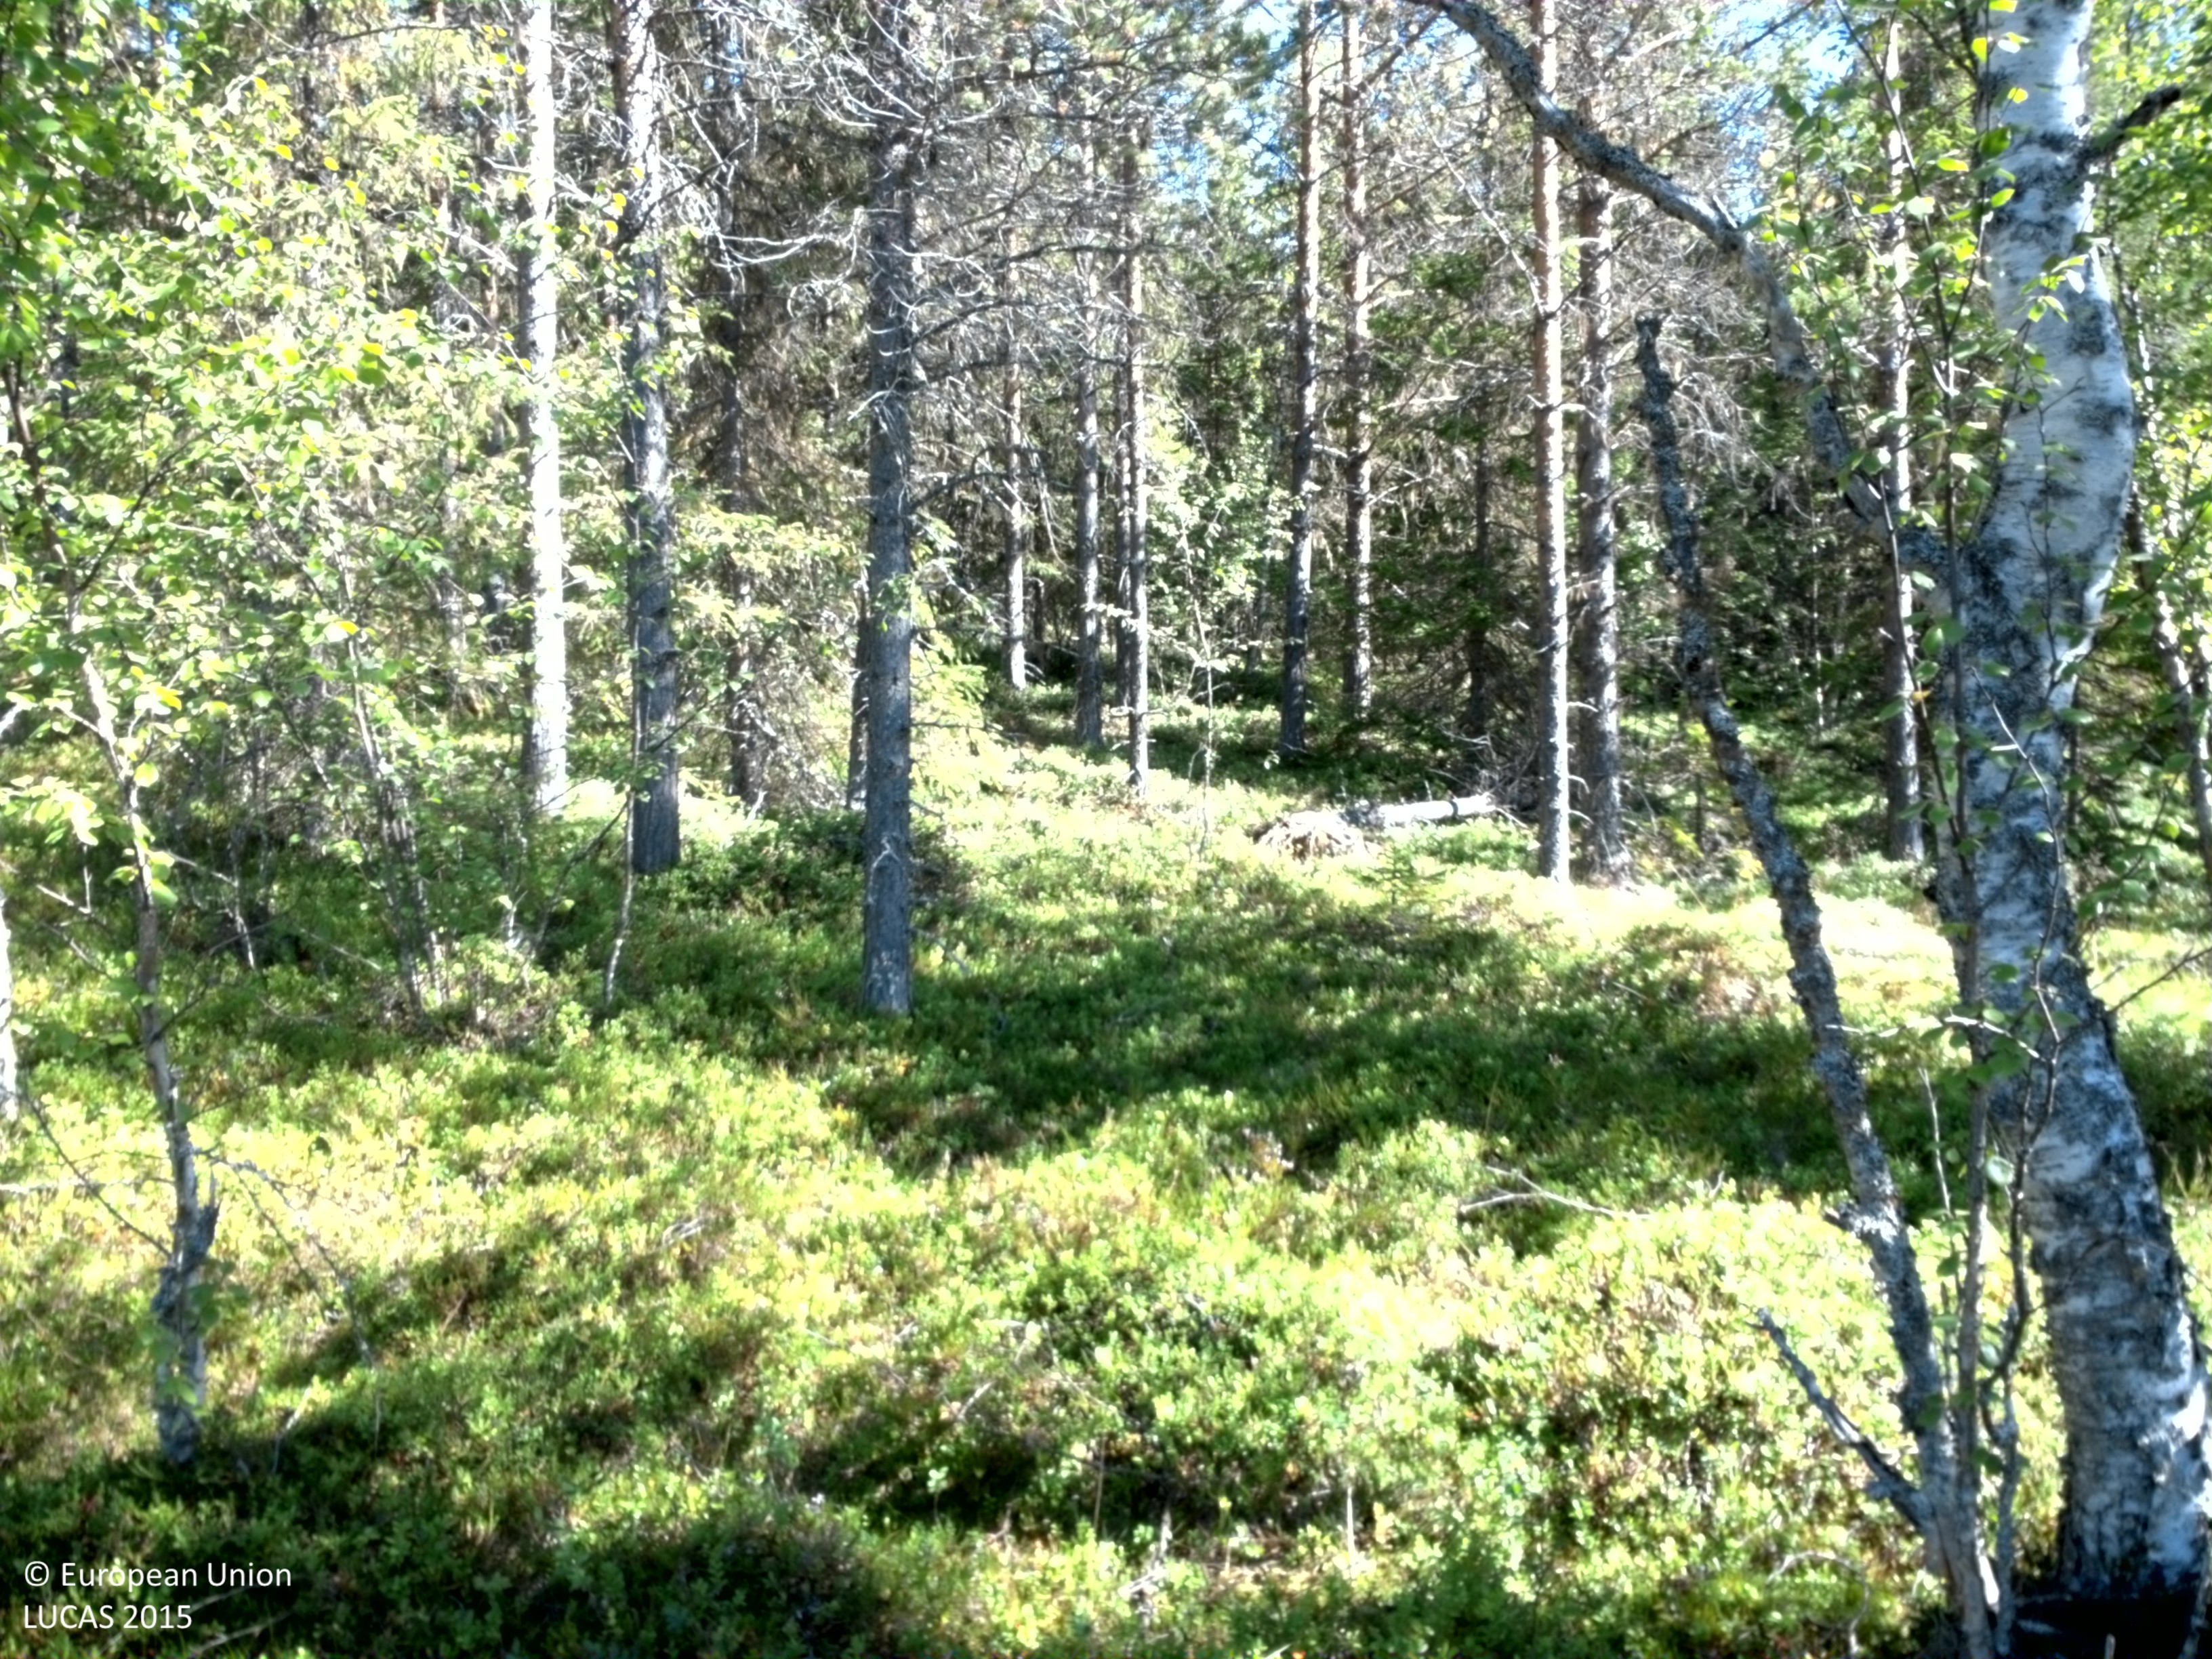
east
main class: Woodland
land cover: Other mixed woodland
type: boreal forest
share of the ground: 25 - 50 %
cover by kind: shrubs 55 %, coniferous forest trees 25 %, broadleaved forest trees 10 %, herbaceous plants 5 %, lichens and mosses 5 %
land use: Forestry
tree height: > 5 m
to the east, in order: Other mixed woodland; Pine dominated coniferous woodland; Spruce dominated coniferous woodland; Spruce dominated mixed woodland; Ditches and canals; Spruce dominated mixed woodland; Pine dominated coniferous woodland; Pine dominated mixed woodland; Ditches and canals; Broadleaved woodland
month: August
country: SE
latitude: 64.7691
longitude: 16.1274
